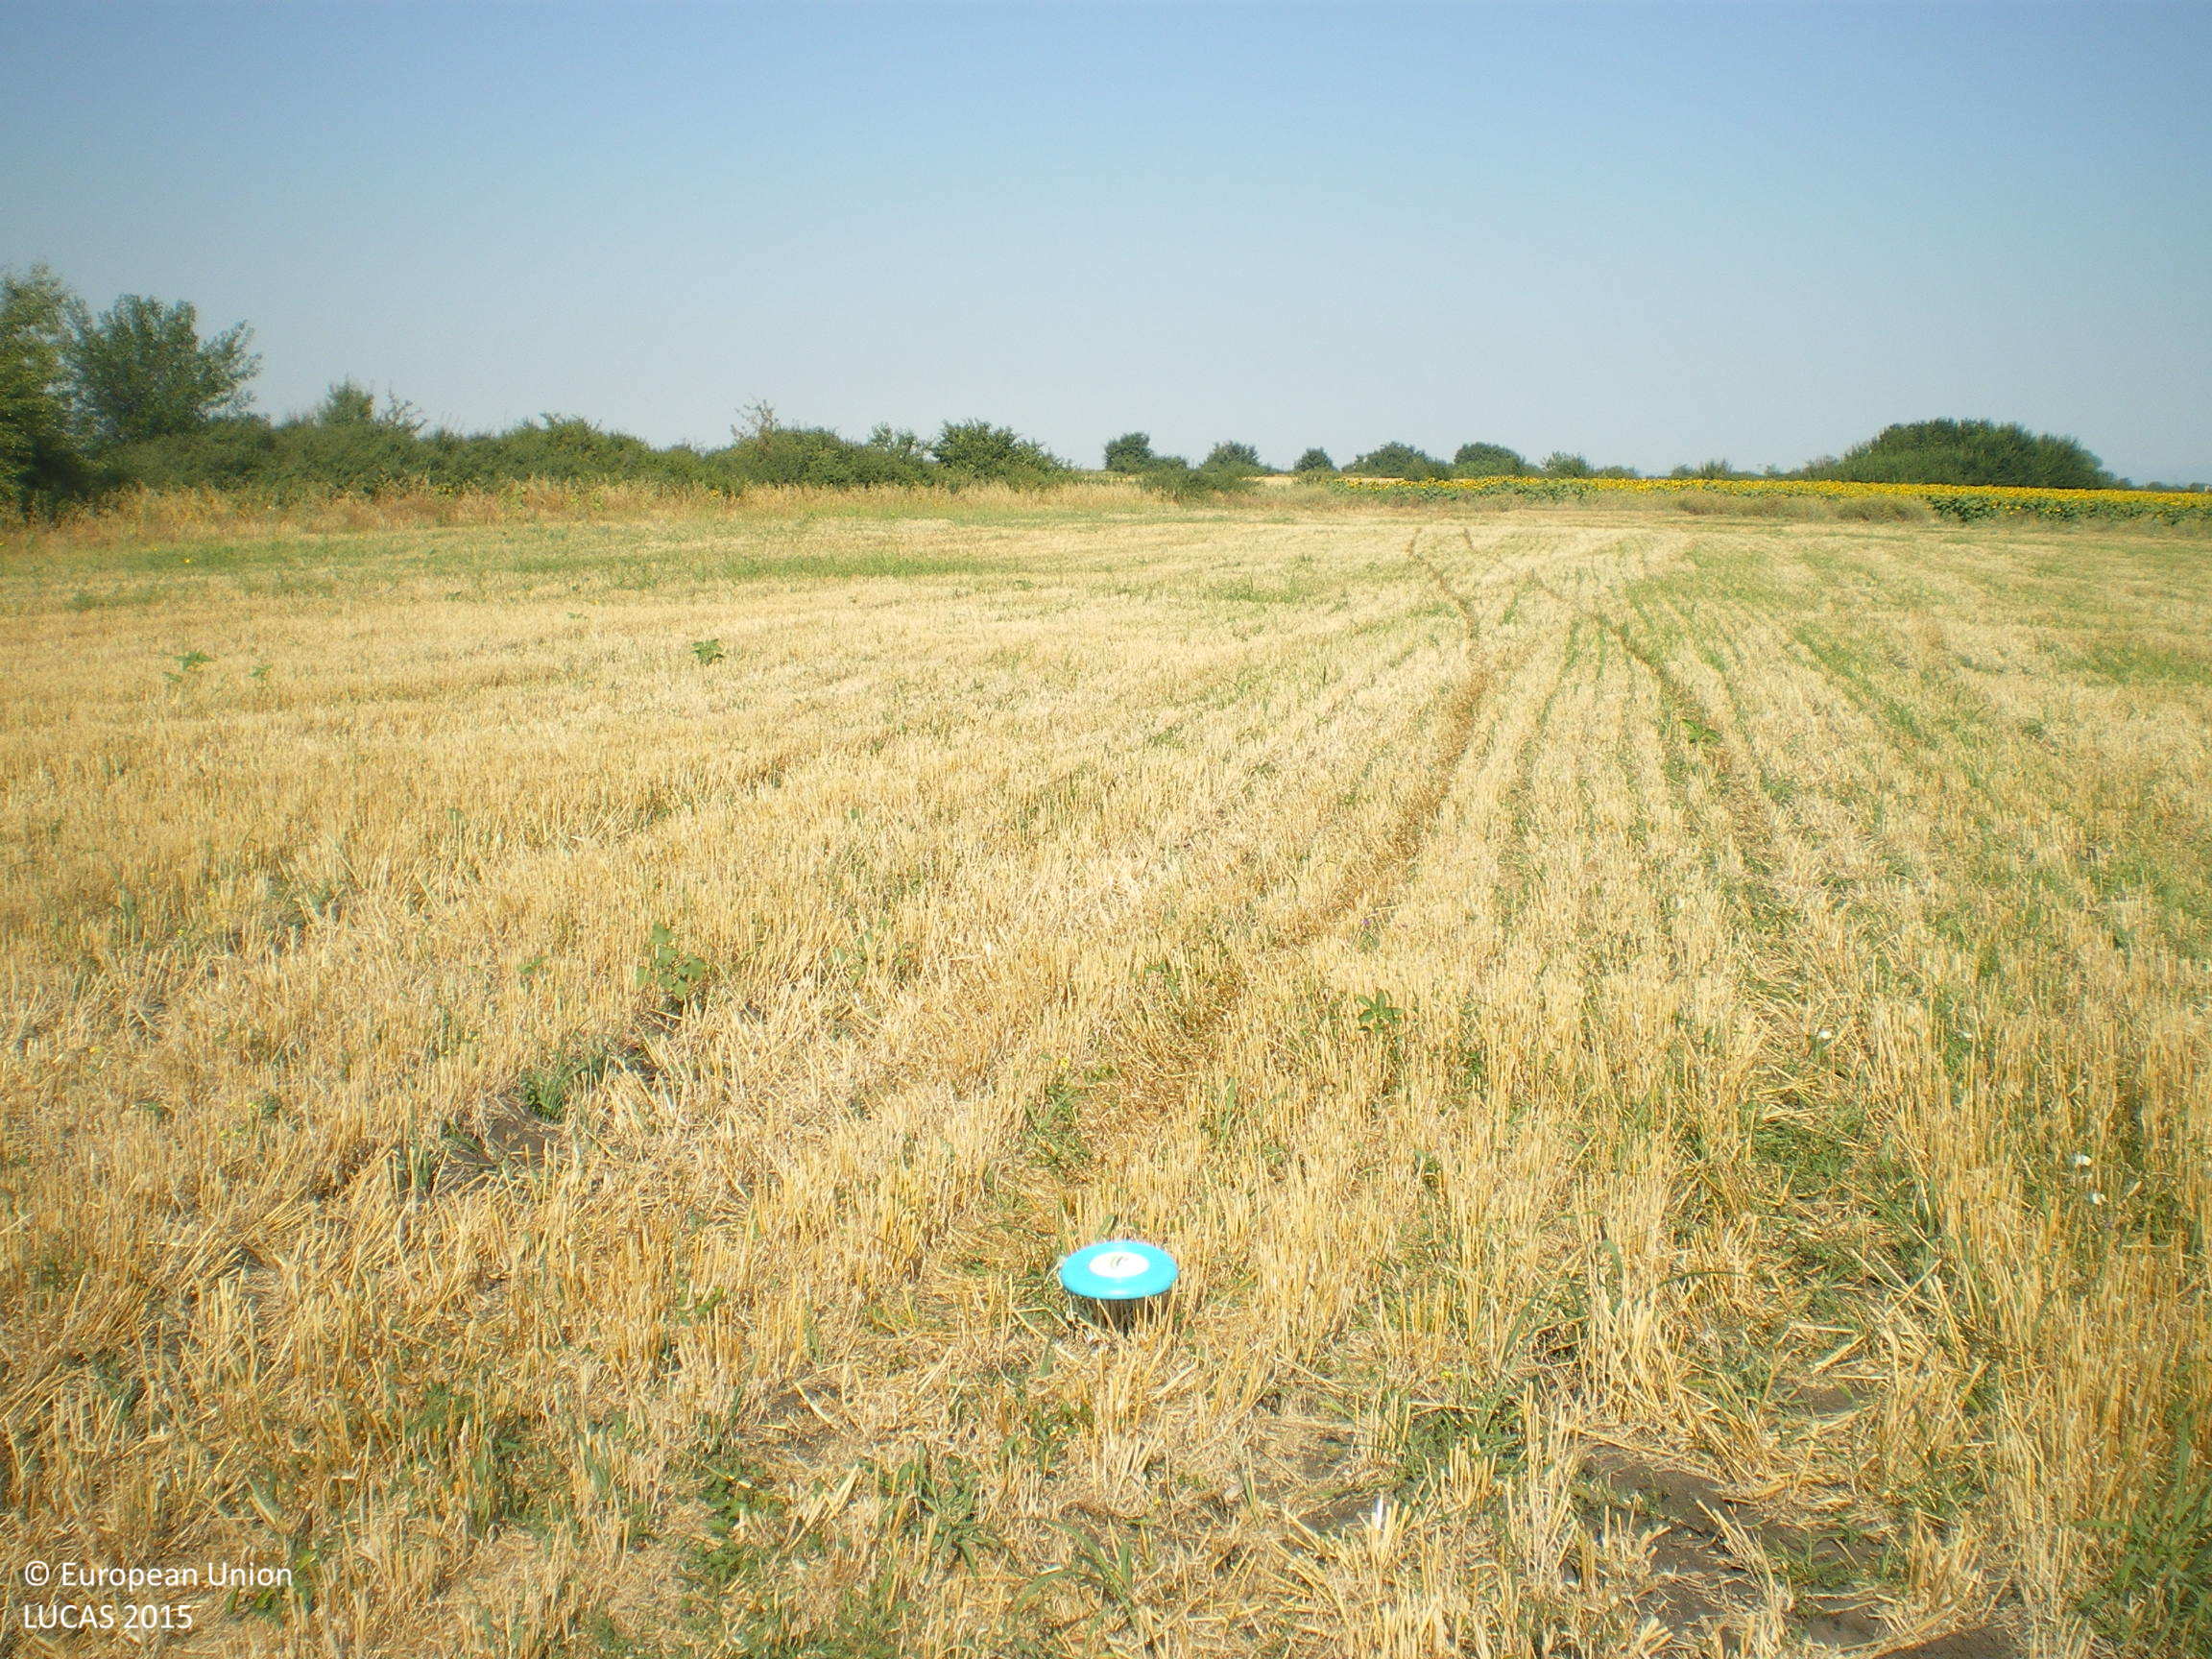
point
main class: Cropland
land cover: Common wheat
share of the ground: 10 - 25 %
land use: Agriculture (excluding fallow land and kitchen gardens)
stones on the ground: < 10 %
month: July
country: BG
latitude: 42.2305
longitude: 25.6891
